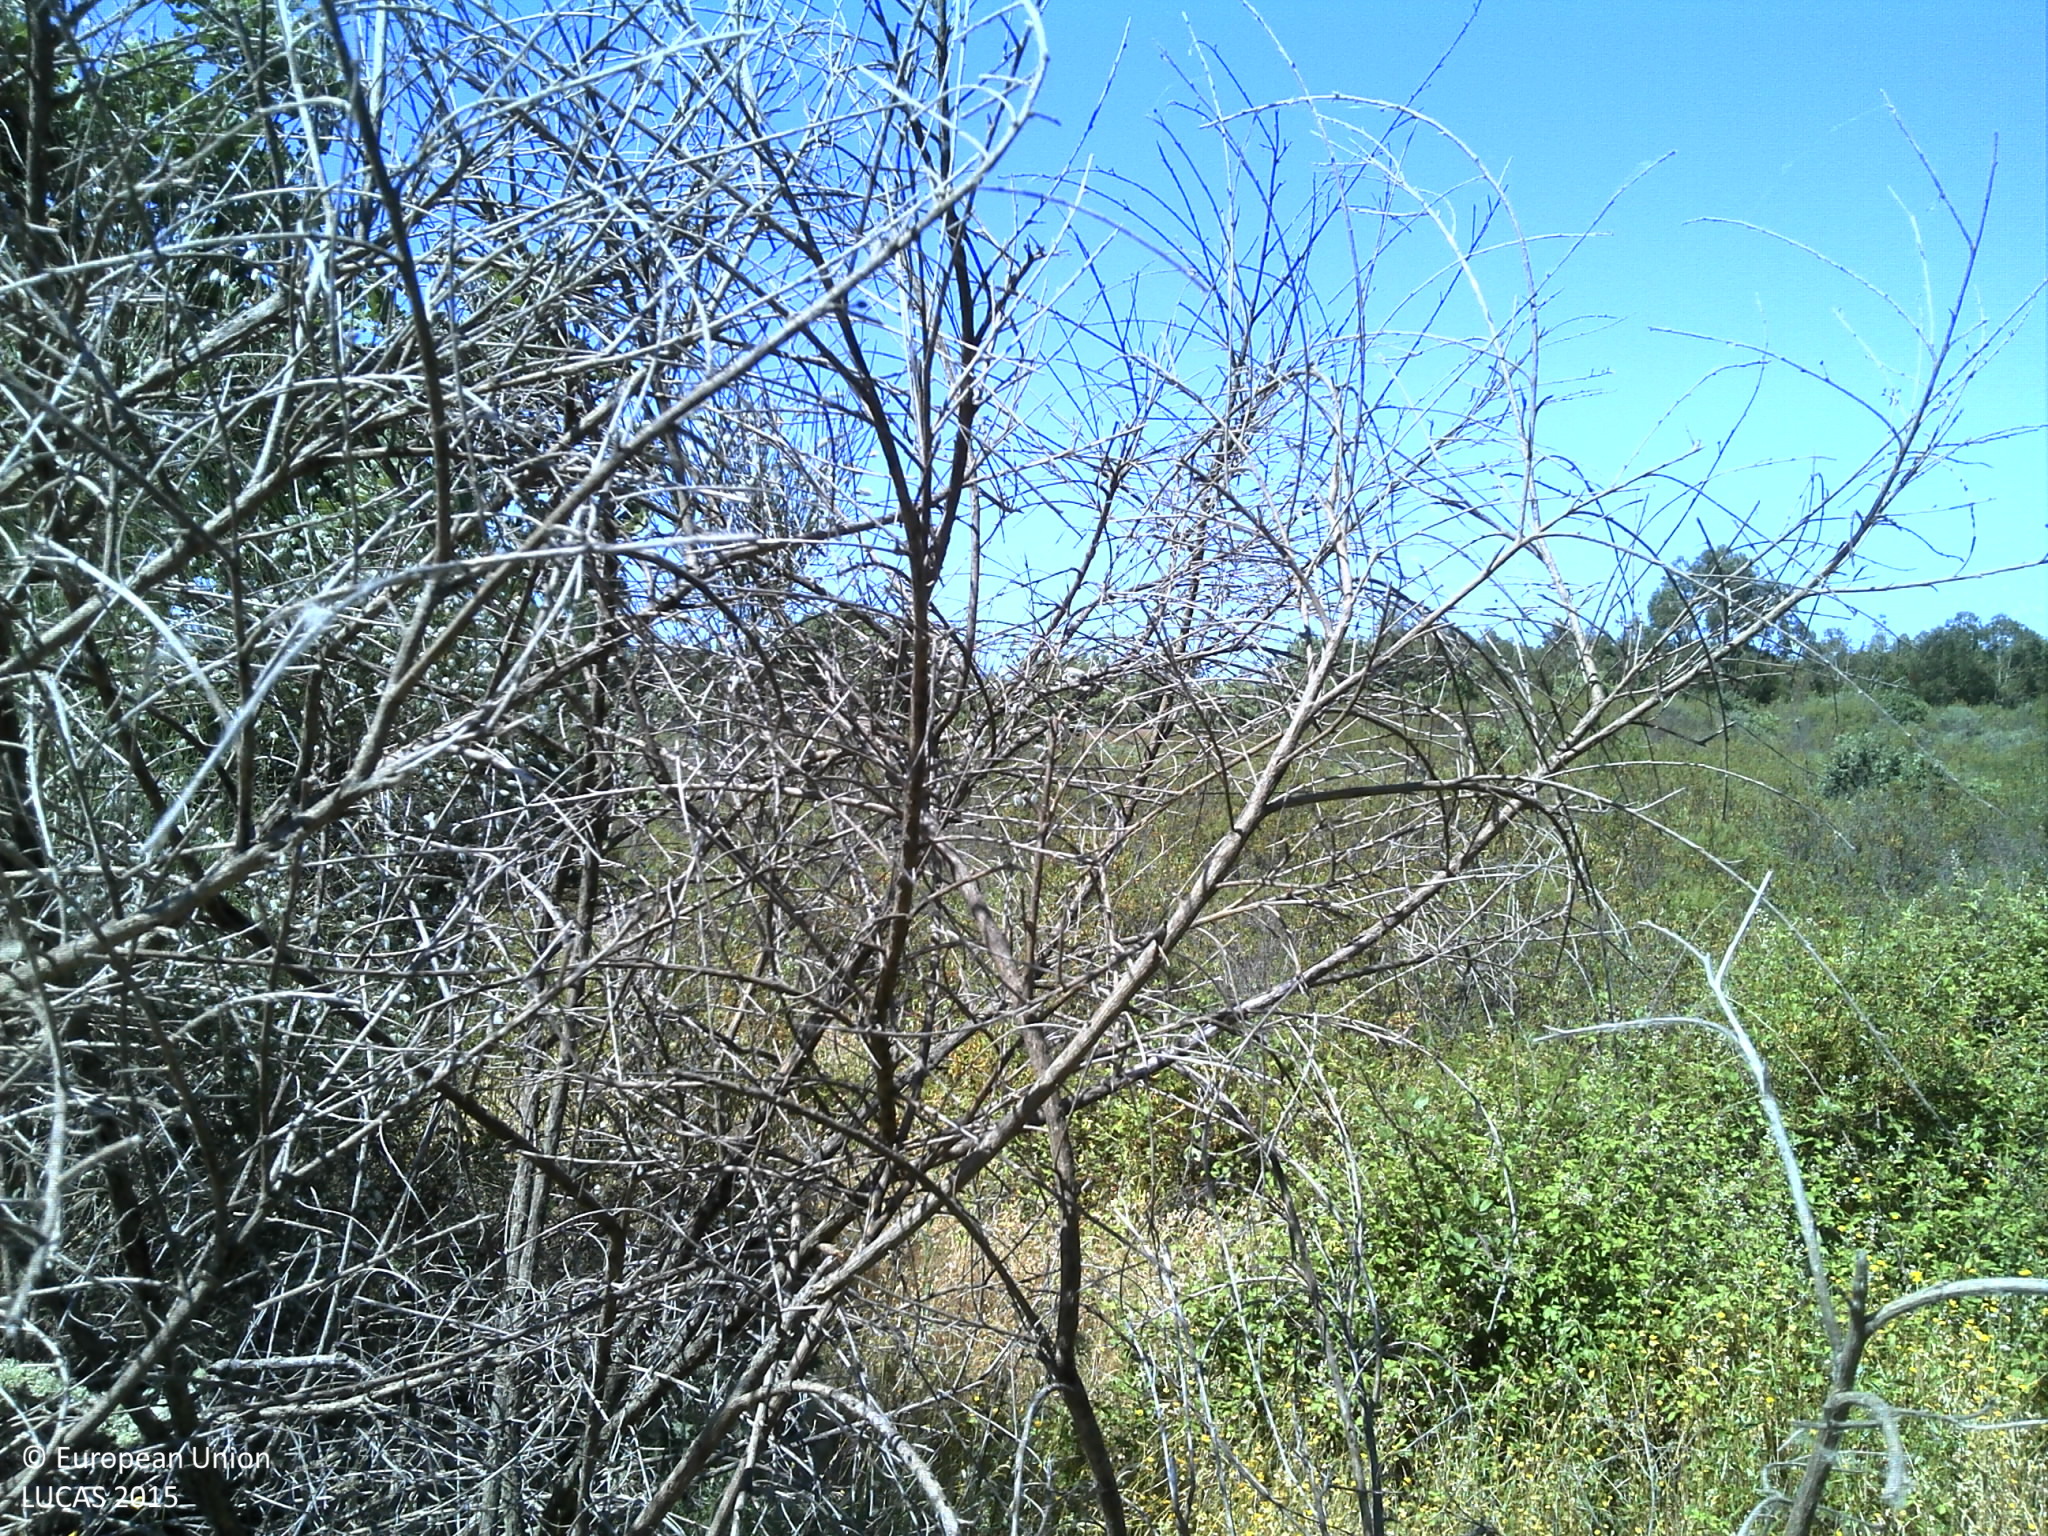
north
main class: Woodland
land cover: Broadleaved woodland
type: broadleaved evergreen forest
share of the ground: 25 - 50 %
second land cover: Shrubland without tree cover
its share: 50 - 75 %
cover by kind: broadleaved forest trees 40 %, shrubs 40 %, herbaceous plants 10 %, unconsolidated bare surface 10 %
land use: Forestry
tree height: > 5 m
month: May
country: PT
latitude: 39.4295
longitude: -7.7445
